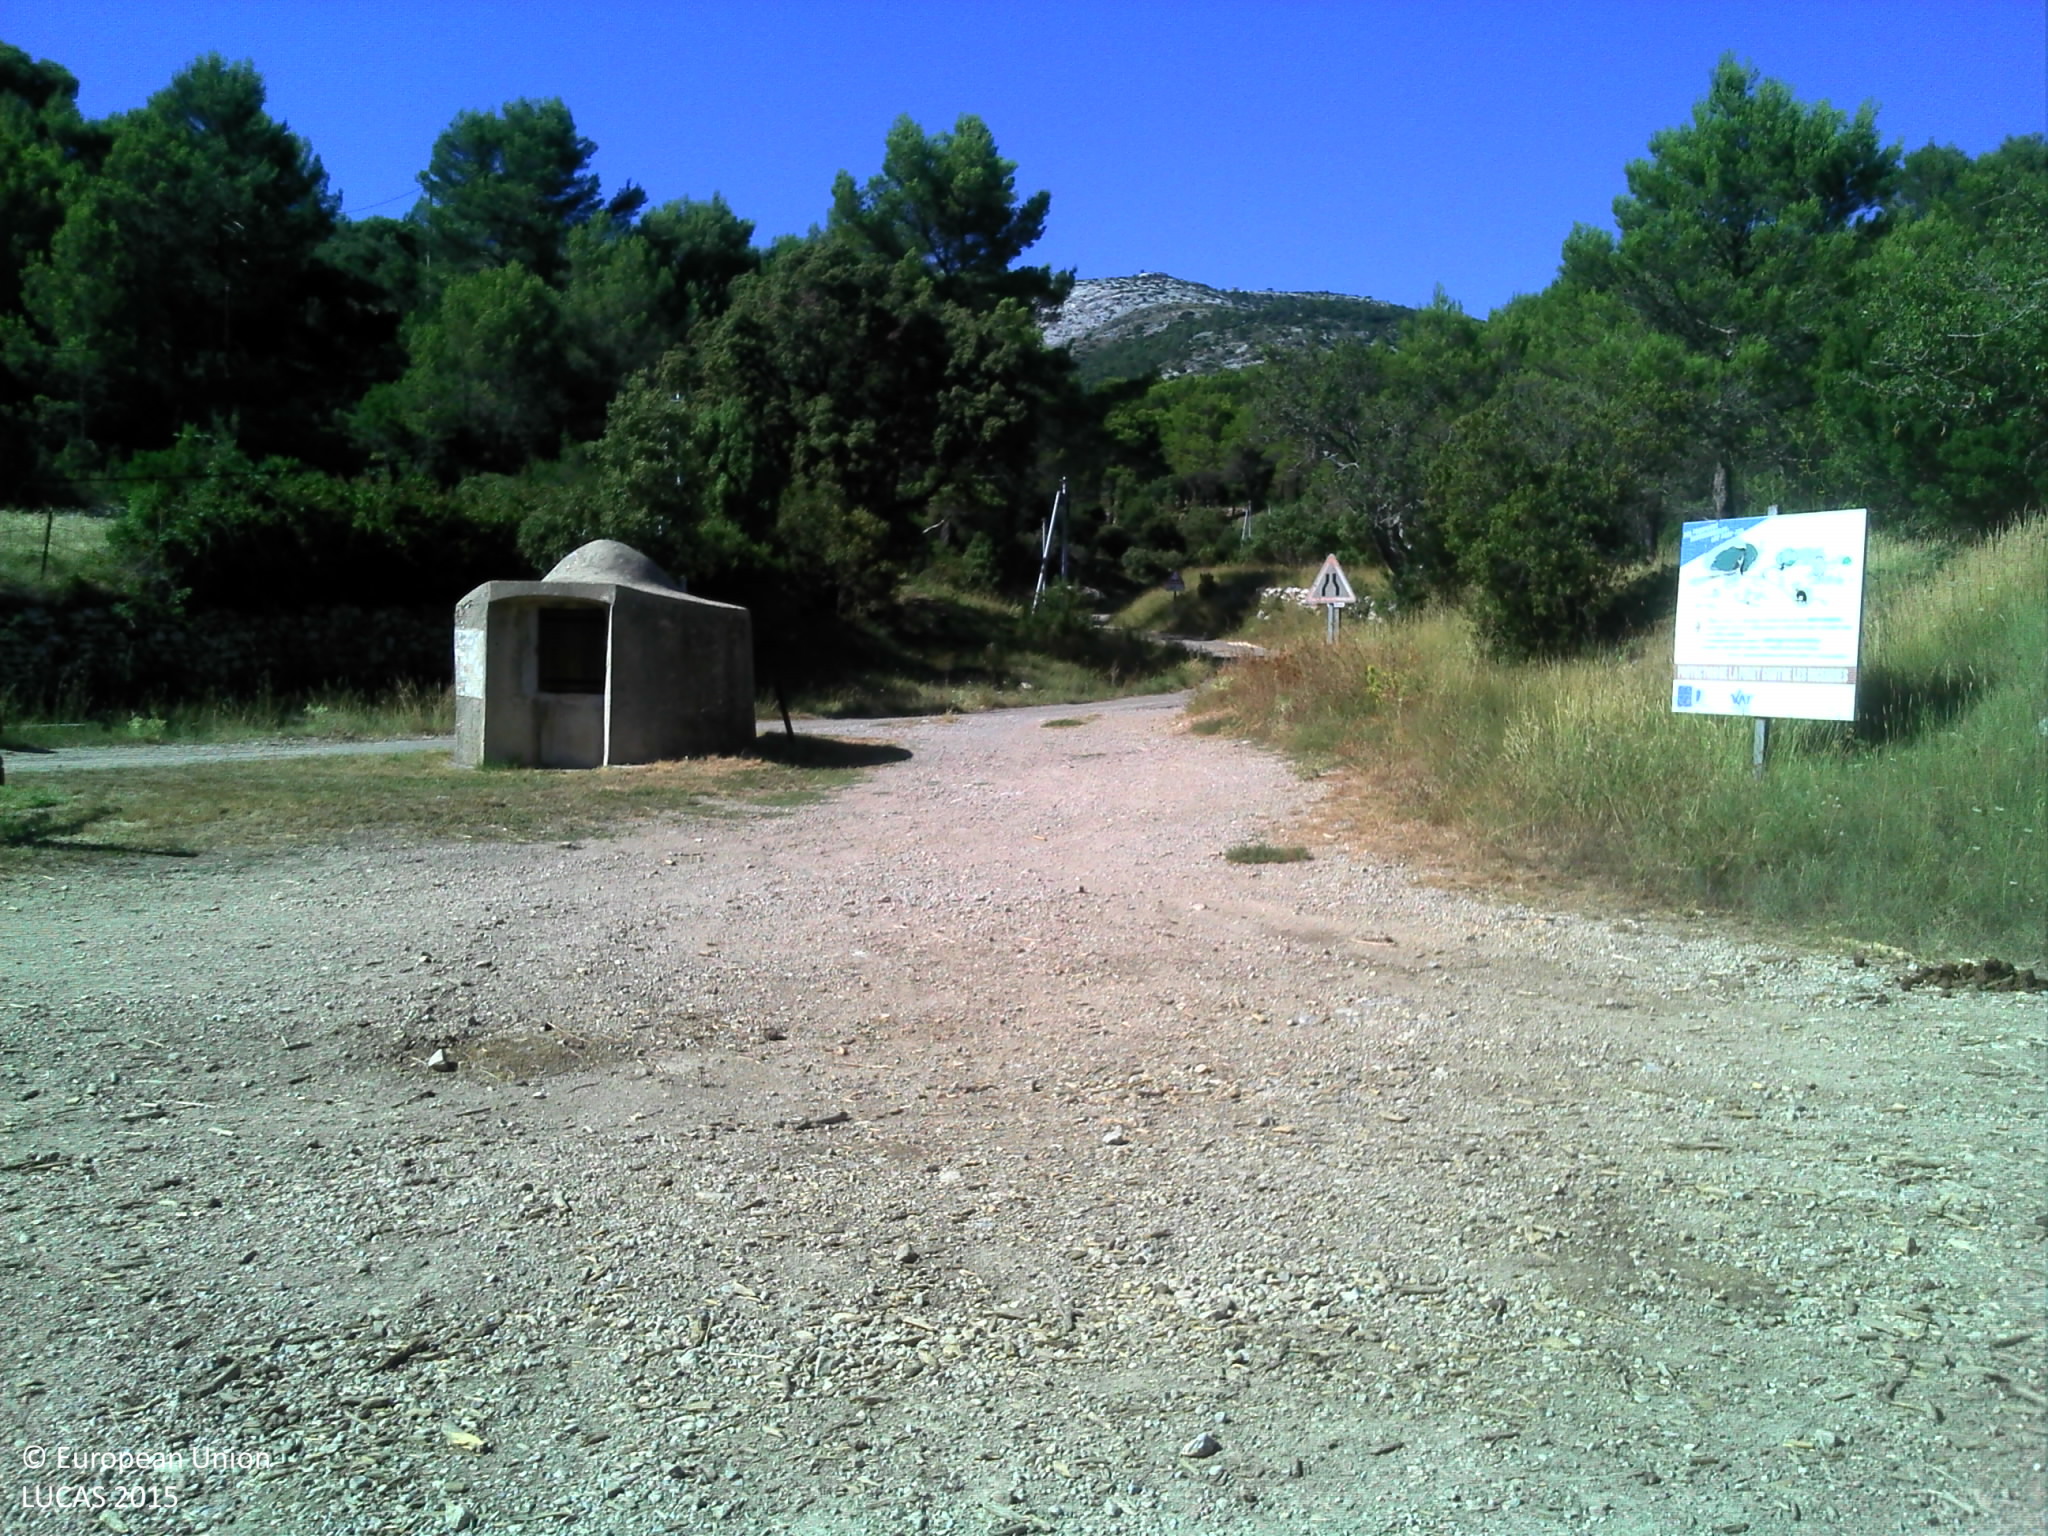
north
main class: Woodland
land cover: Pine dominated coniferous woodland
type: coniferous forest of the mediterranean region
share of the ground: > 75 %
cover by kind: coniferous forest trees 90 %, shrubs 10 %
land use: Semi-natural and natural areas not in use
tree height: > 5 m
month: July
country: FR
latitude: 43.3073
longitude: 5.7813
